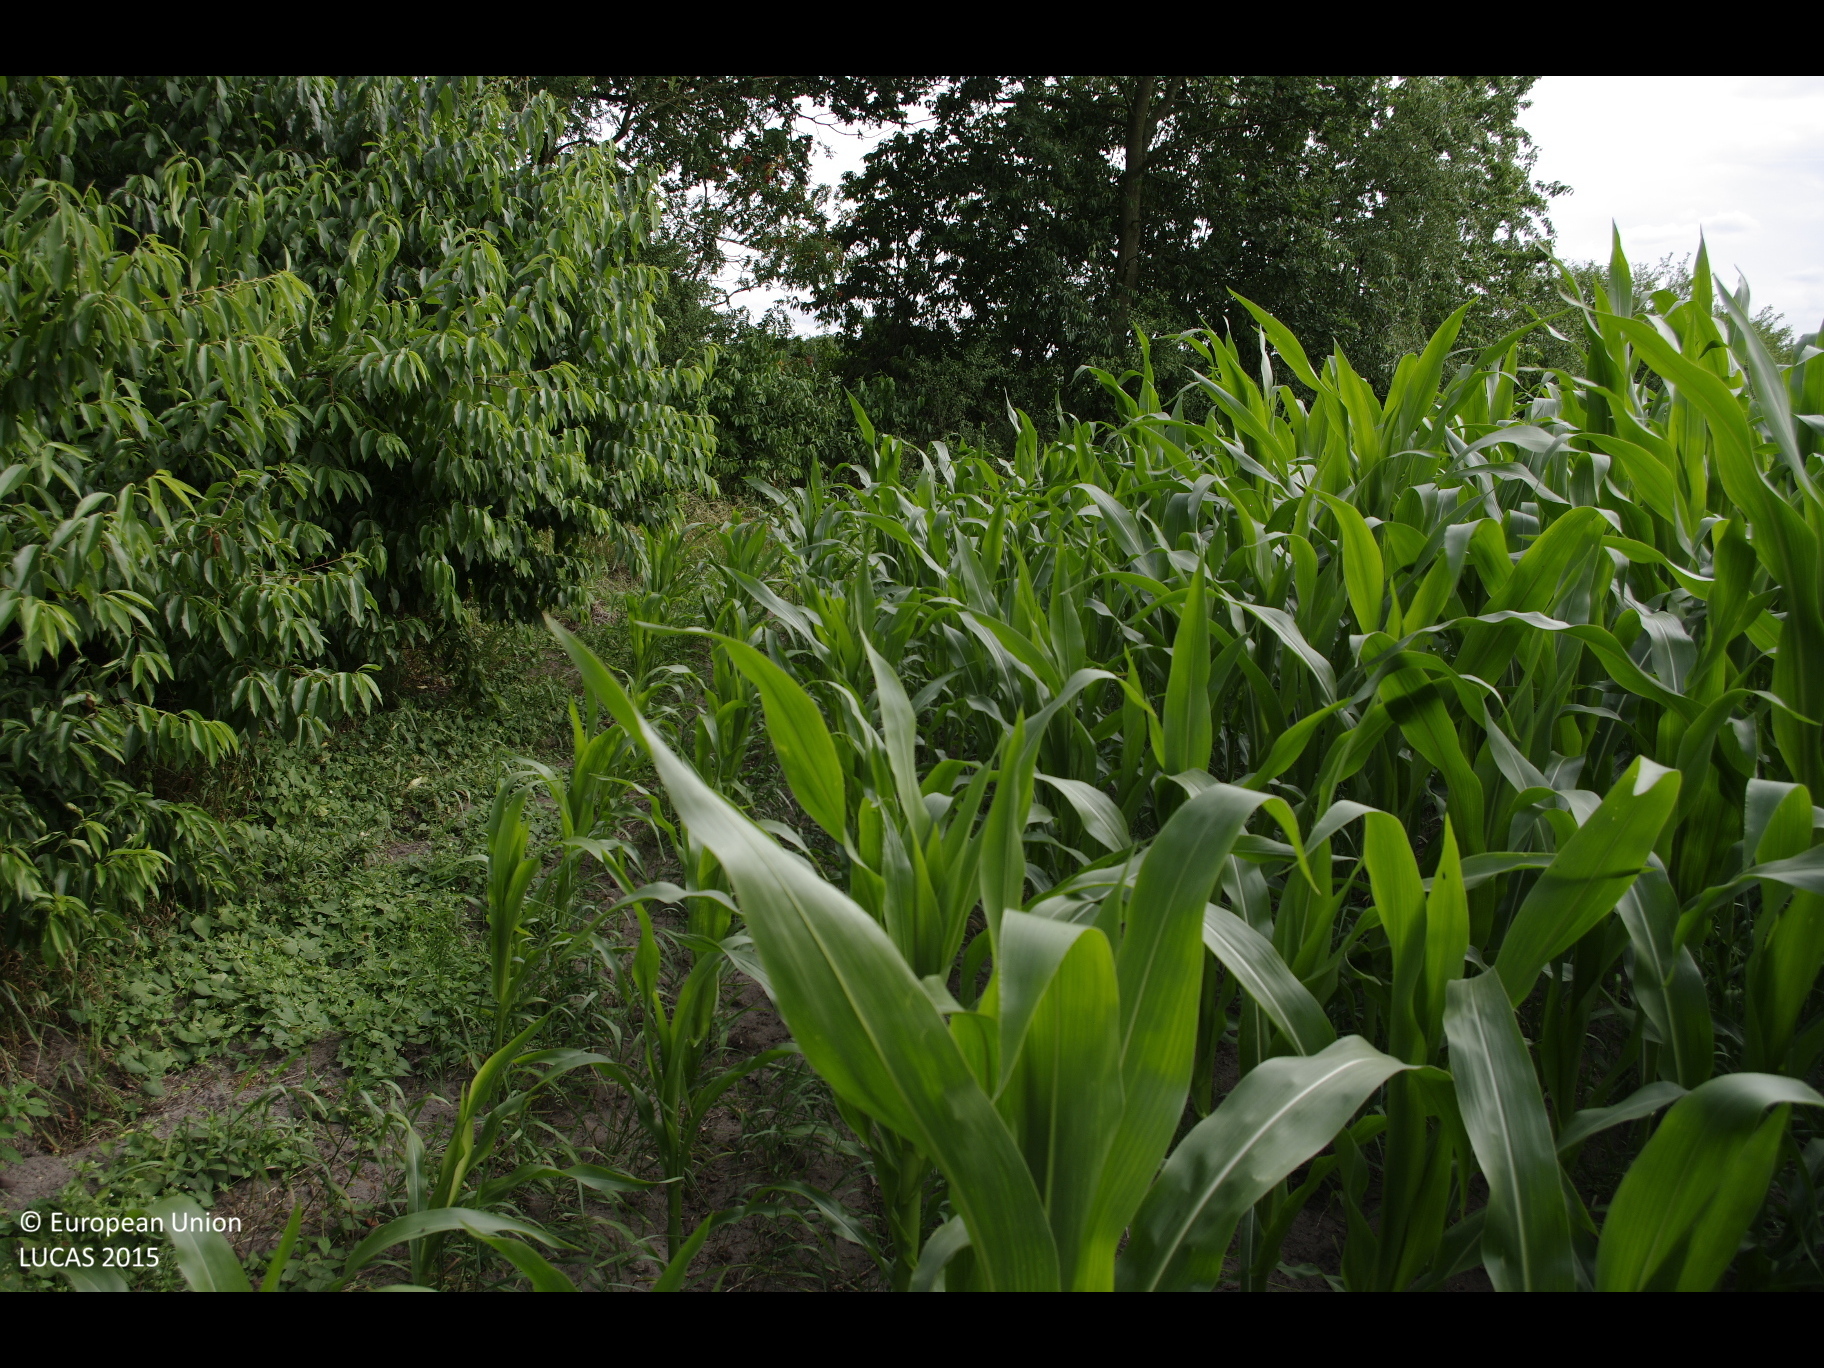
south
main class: Cropland
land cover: Maize
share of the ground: > 75 %
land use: Agriculture (excluding fallow land and kitchen gardens)
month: July
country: DE
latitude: 53.9950
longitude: 9.9543
